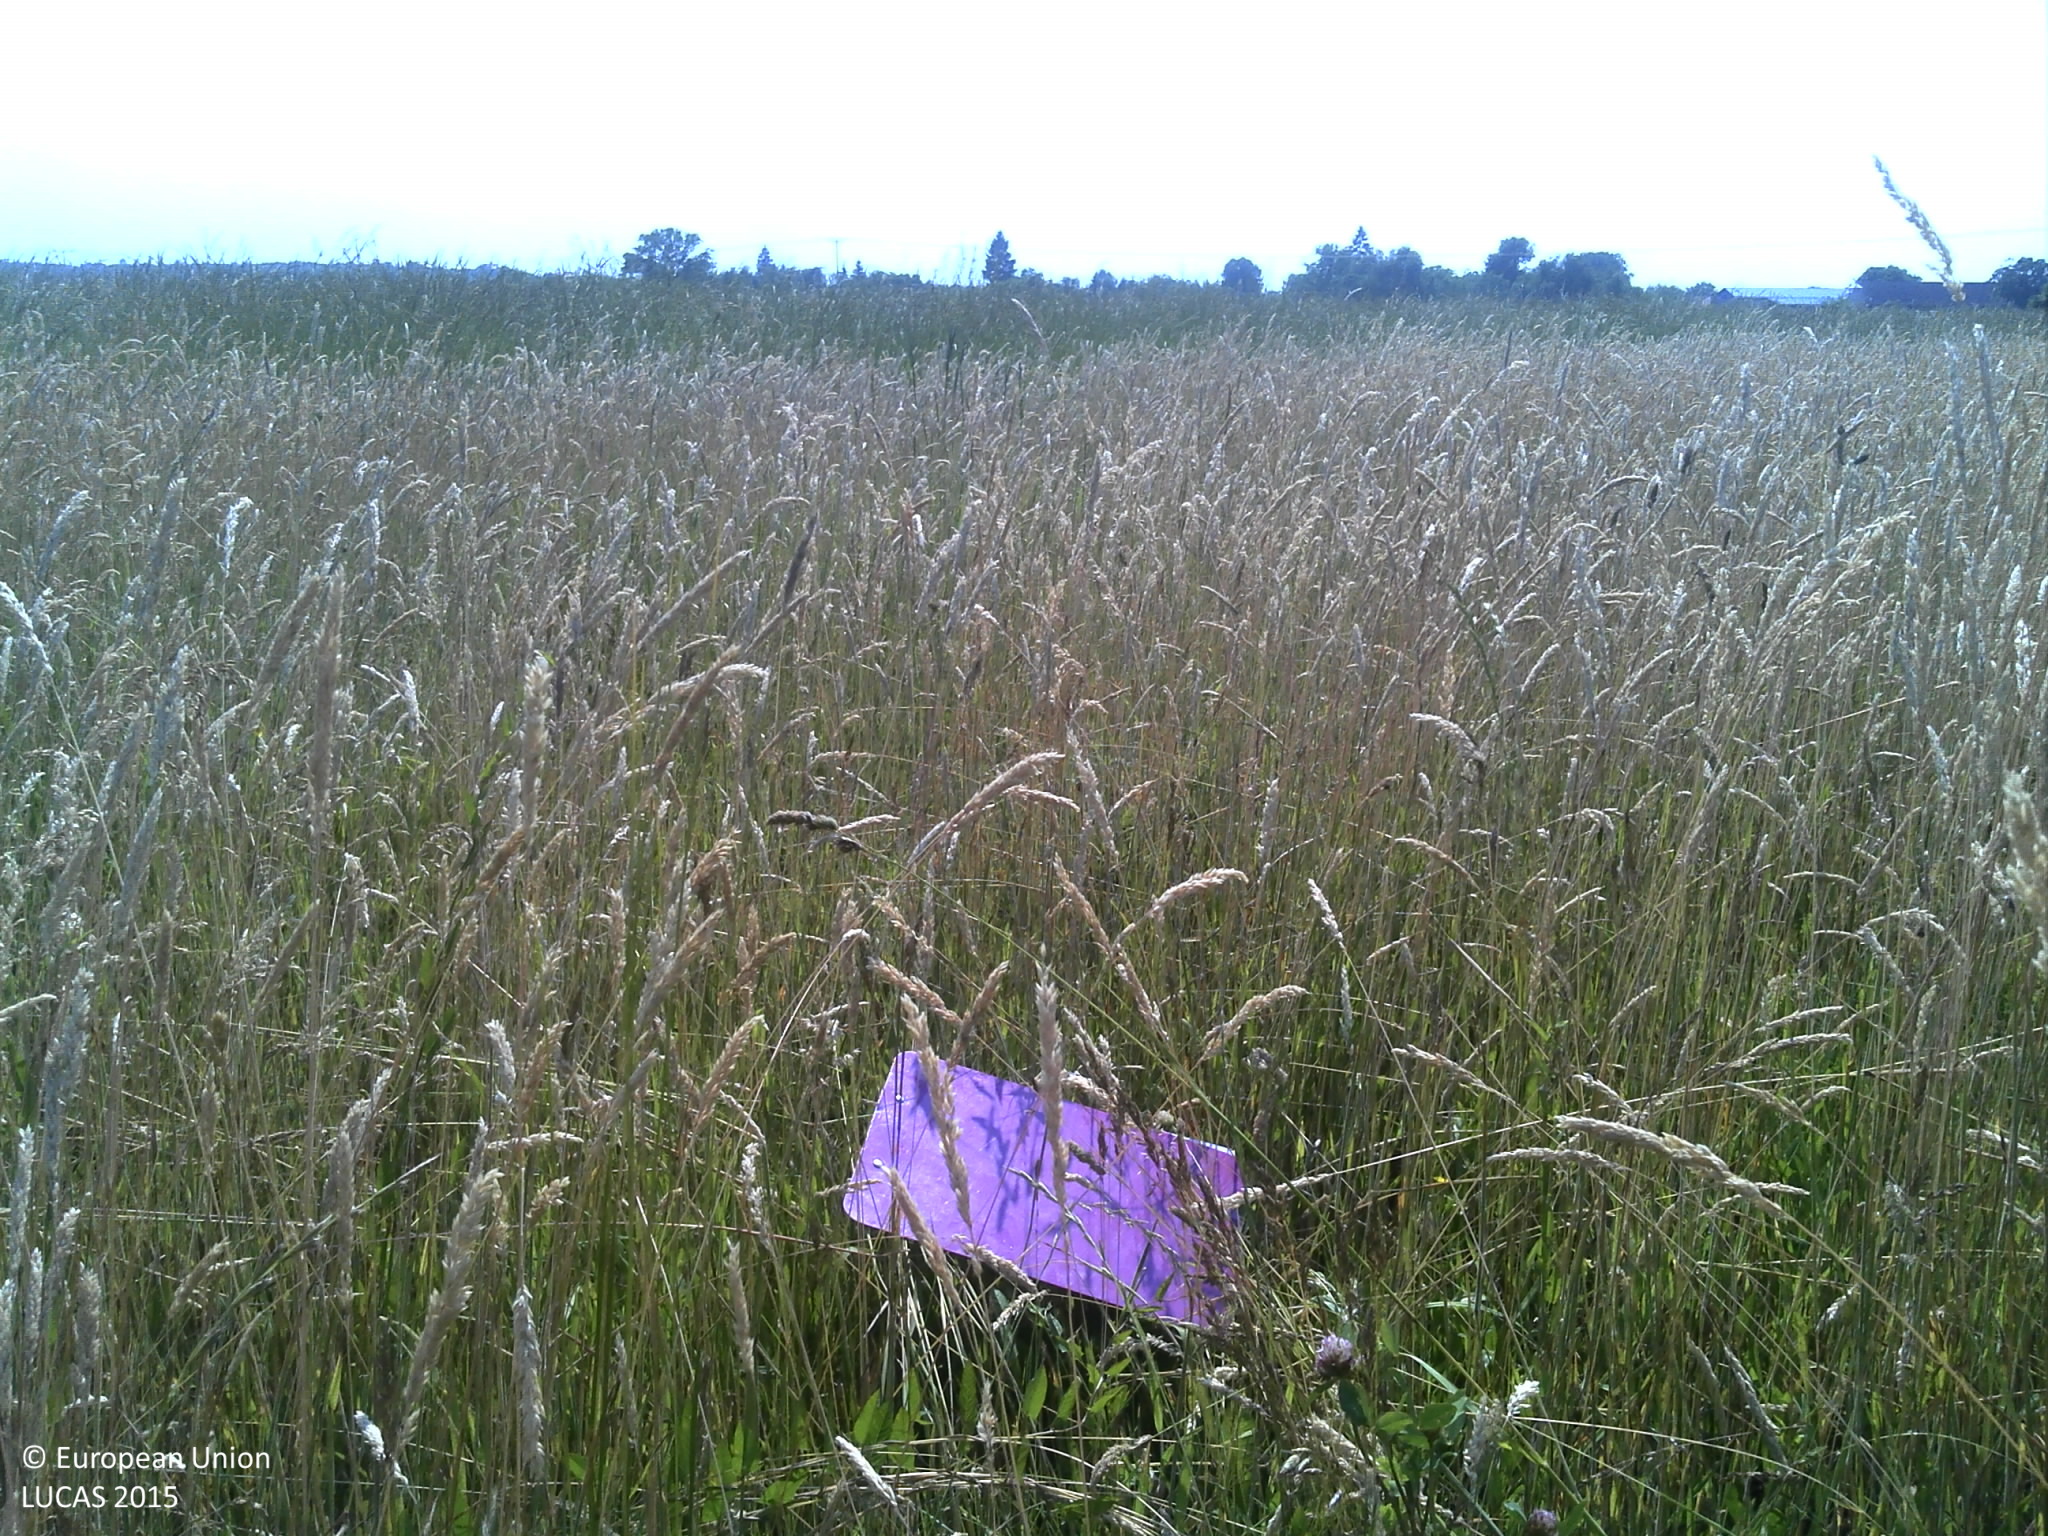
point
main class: Grassland
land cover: Spontaneously vegetated surfaces
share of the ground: > 75 %
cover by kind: herbaceous plants 100 %
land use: Fallow land
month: June
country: HR
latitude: 45.7004
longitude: 17.8511
